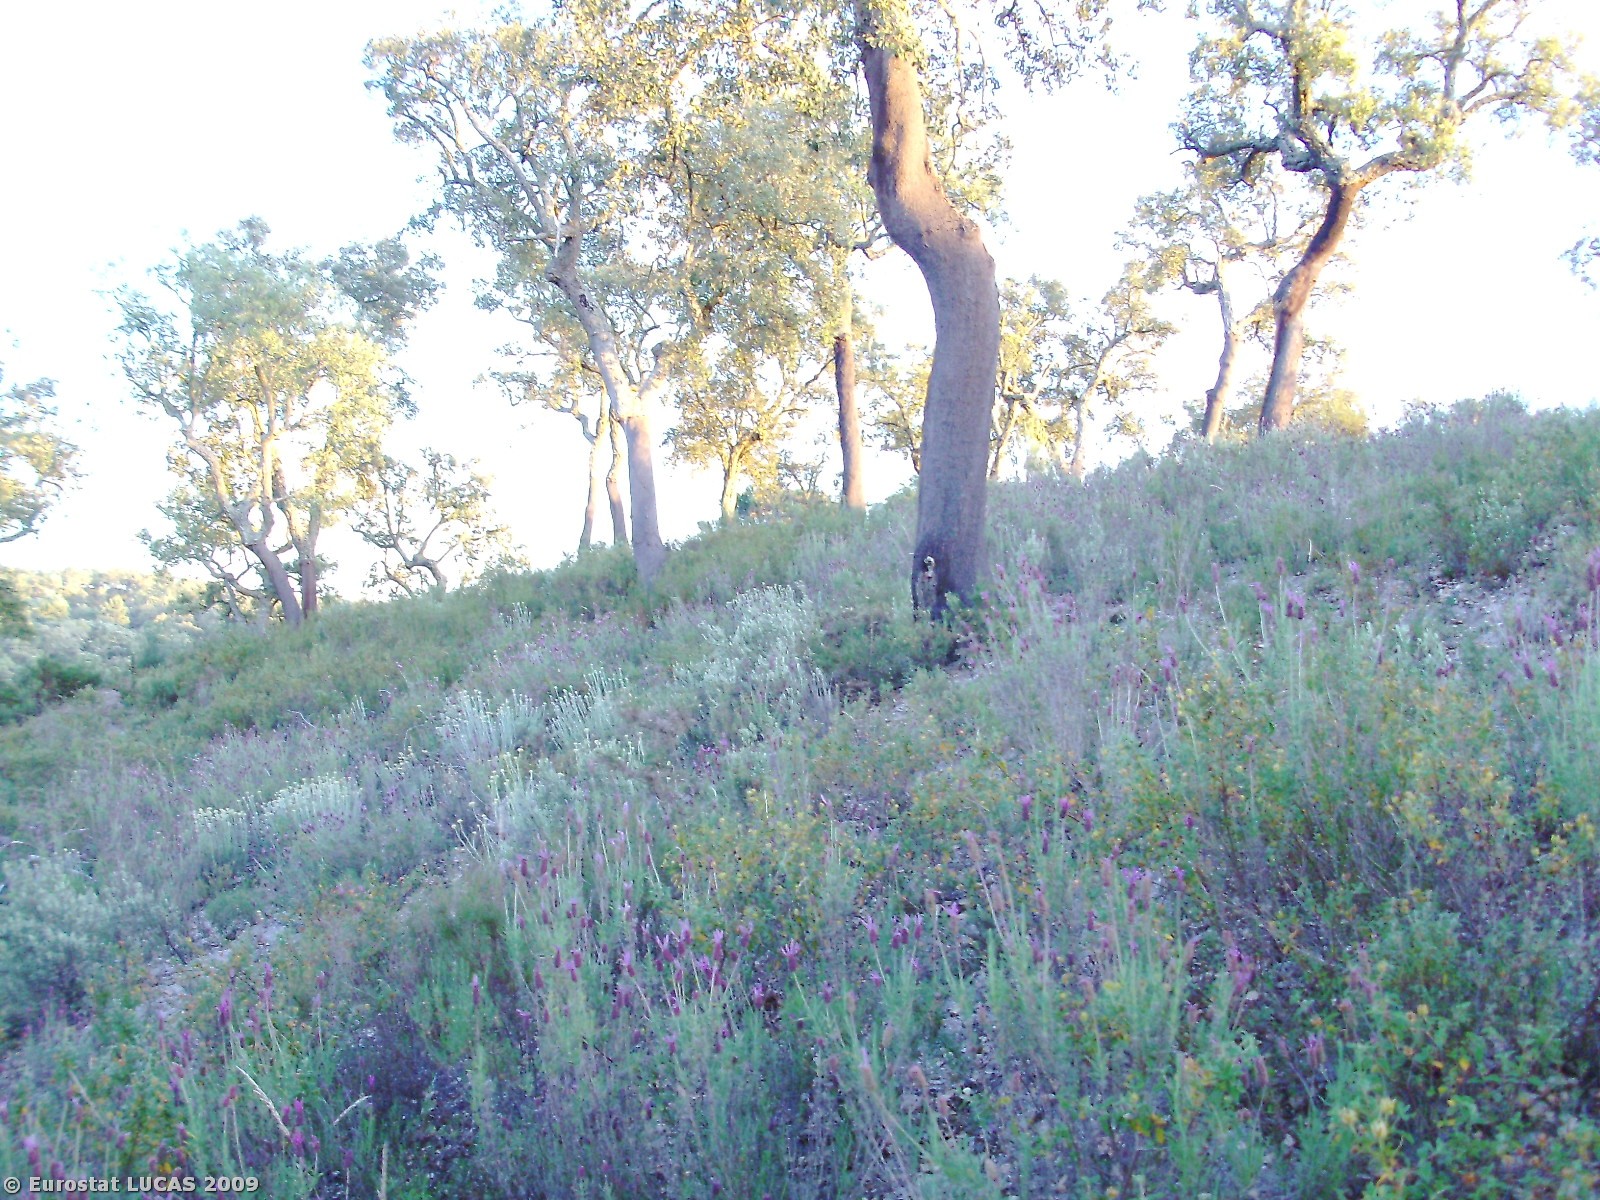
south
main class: Woodland
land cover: Broadleaved woodland
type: broadleaved evergreen forest
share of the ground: 25 - 50 %
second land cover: Spontaneously vegetated surfaces
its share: 50 - 75 %
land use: Forestry
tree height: > 5 m
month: May
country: PT
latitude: 39.1771
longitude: -8.0072
